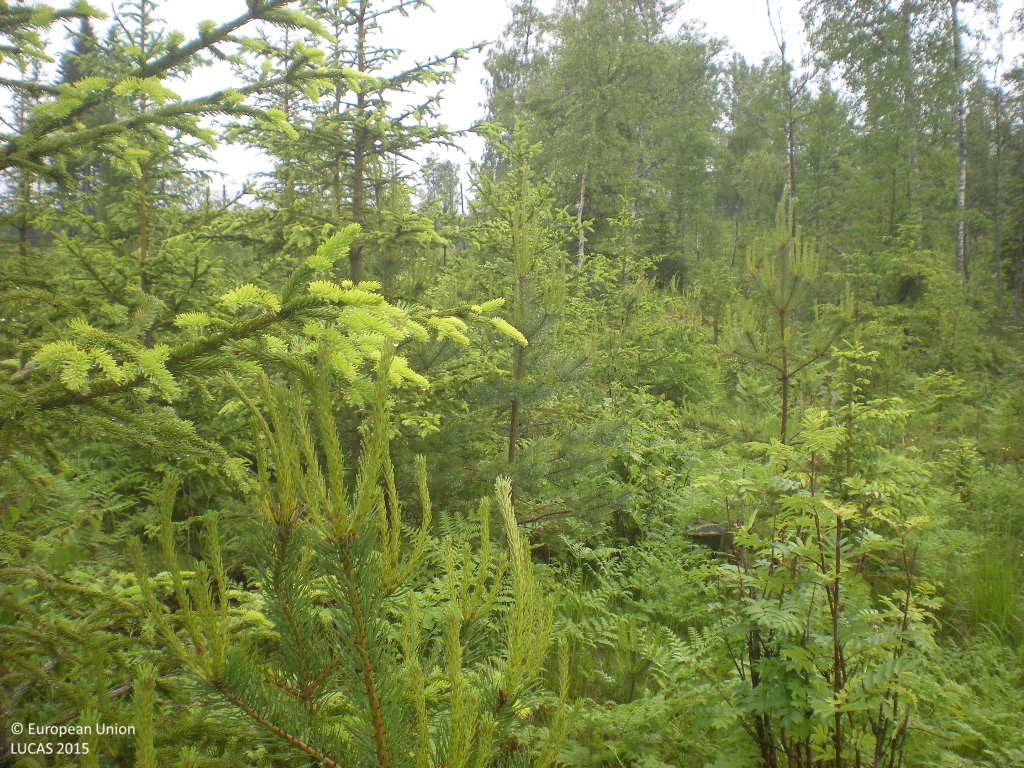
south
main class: Woodland
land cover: Other coniferous woodland
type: boreal forest
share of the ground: 25 - 50 %
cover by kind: coniferous forest trees 50 %, herbaceous plants 30 %, shrubs 10 %, lichens and mosses 5 %, consolidated bare surface 5 %
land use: Forestry
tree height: < 5 m
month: June
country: SE
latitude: 60.3943
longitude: 17.8865
